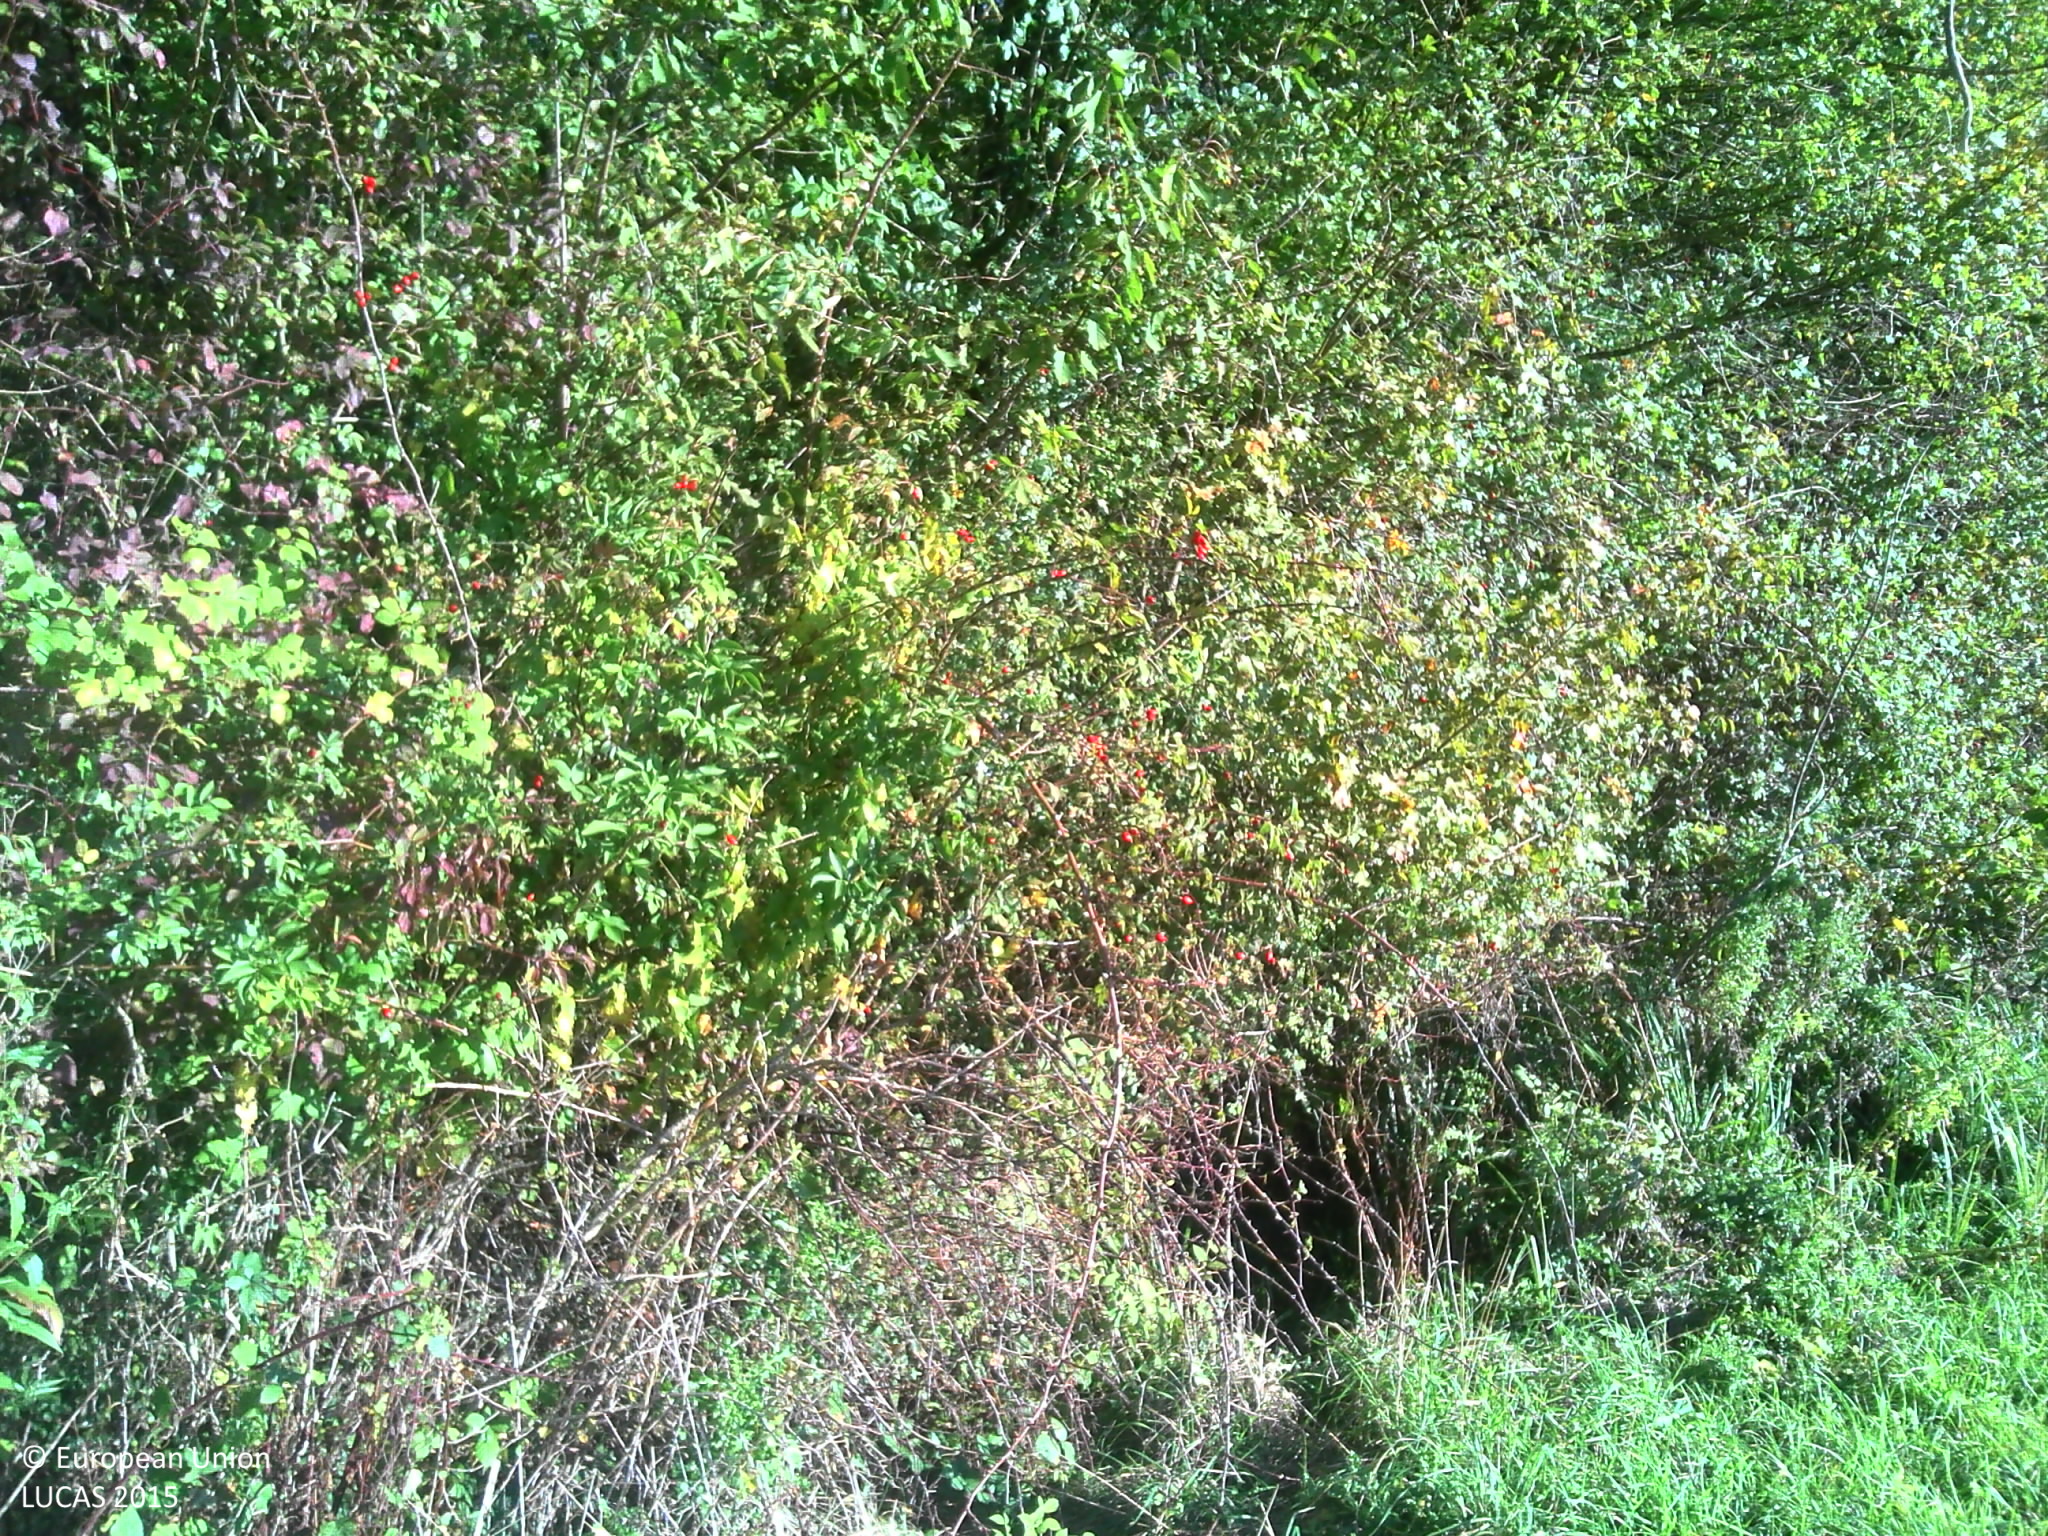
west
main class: Cropland
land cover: Temporary grasslands
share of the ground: > 75 %
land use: Agriculture (excluding fallow land and kitchen gardens)
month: October
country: FR
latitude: 49.1411
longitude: 5.9831
